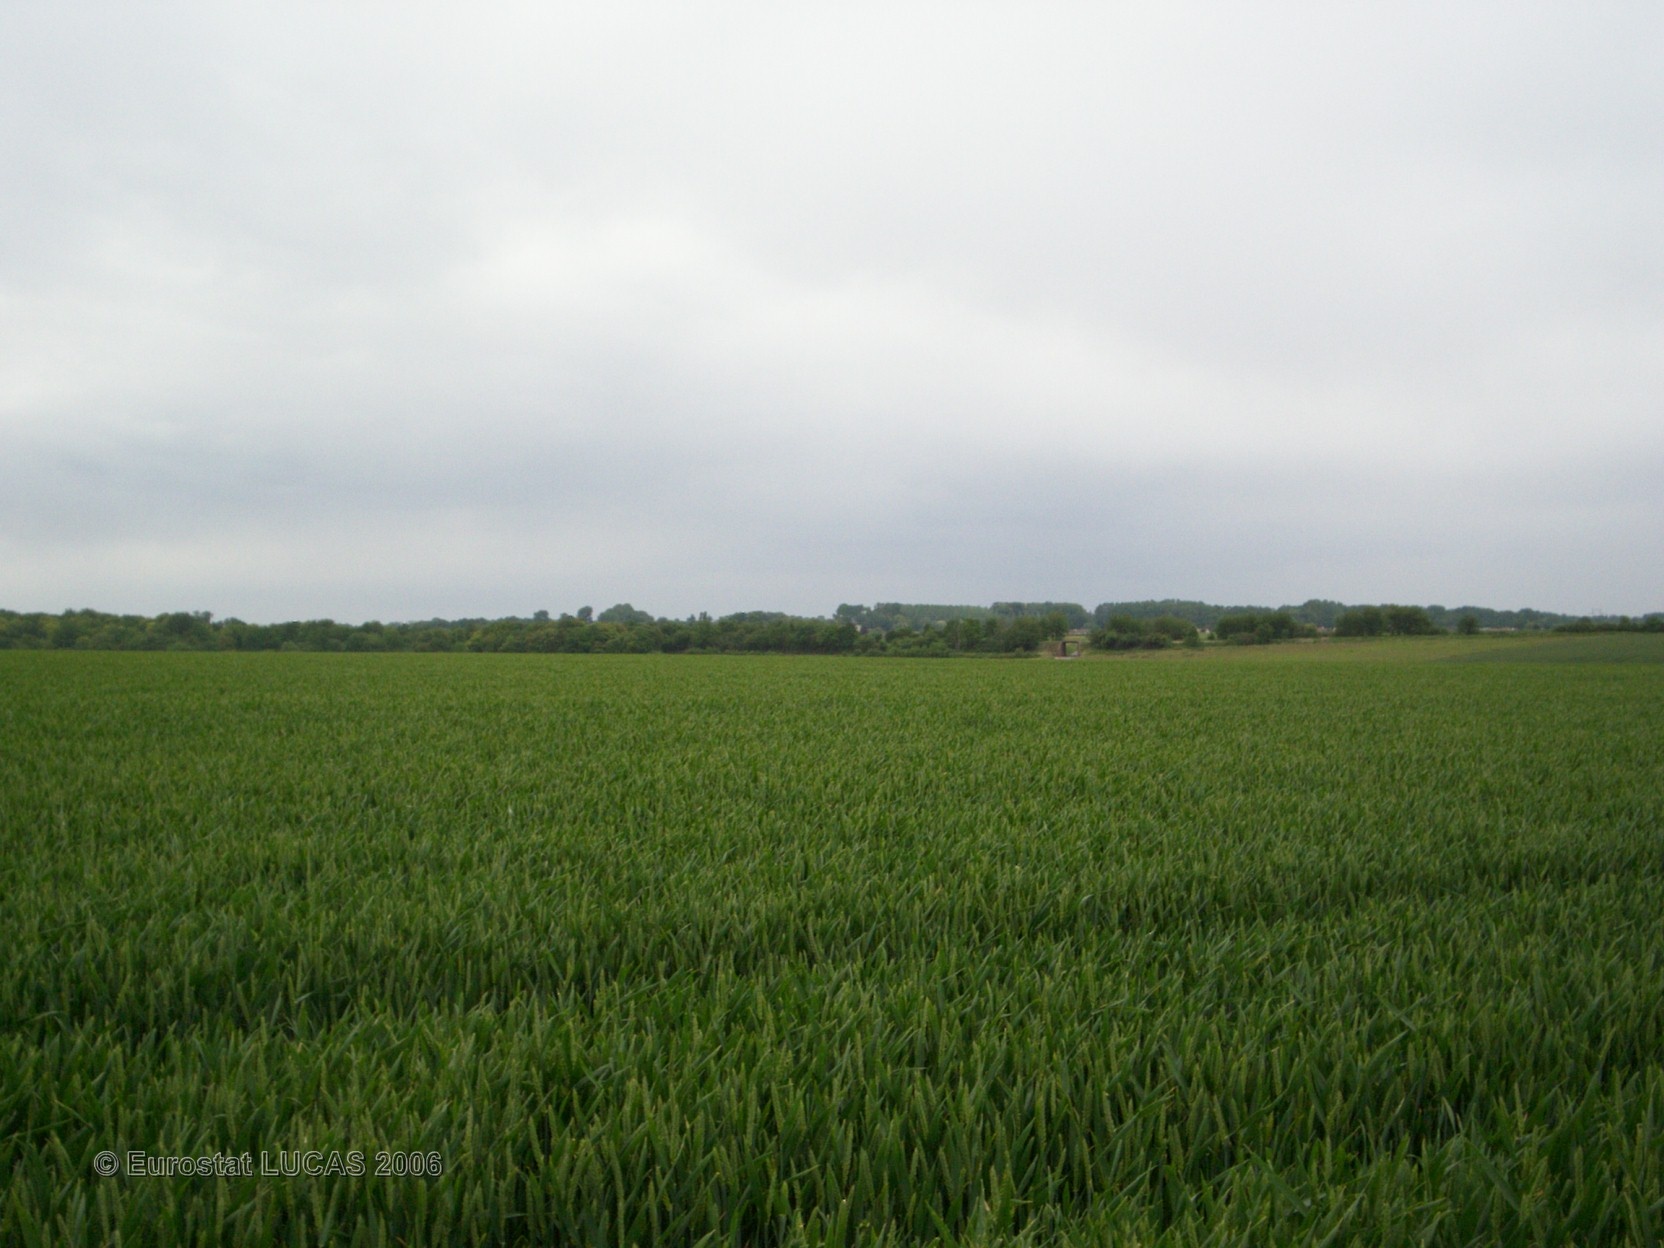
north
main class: Cropland
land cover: Common wheat
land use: Agriculture (excluding fallow land and kitchen gardens)
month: June
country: FR
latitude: 49.3886
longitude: 2.6736
